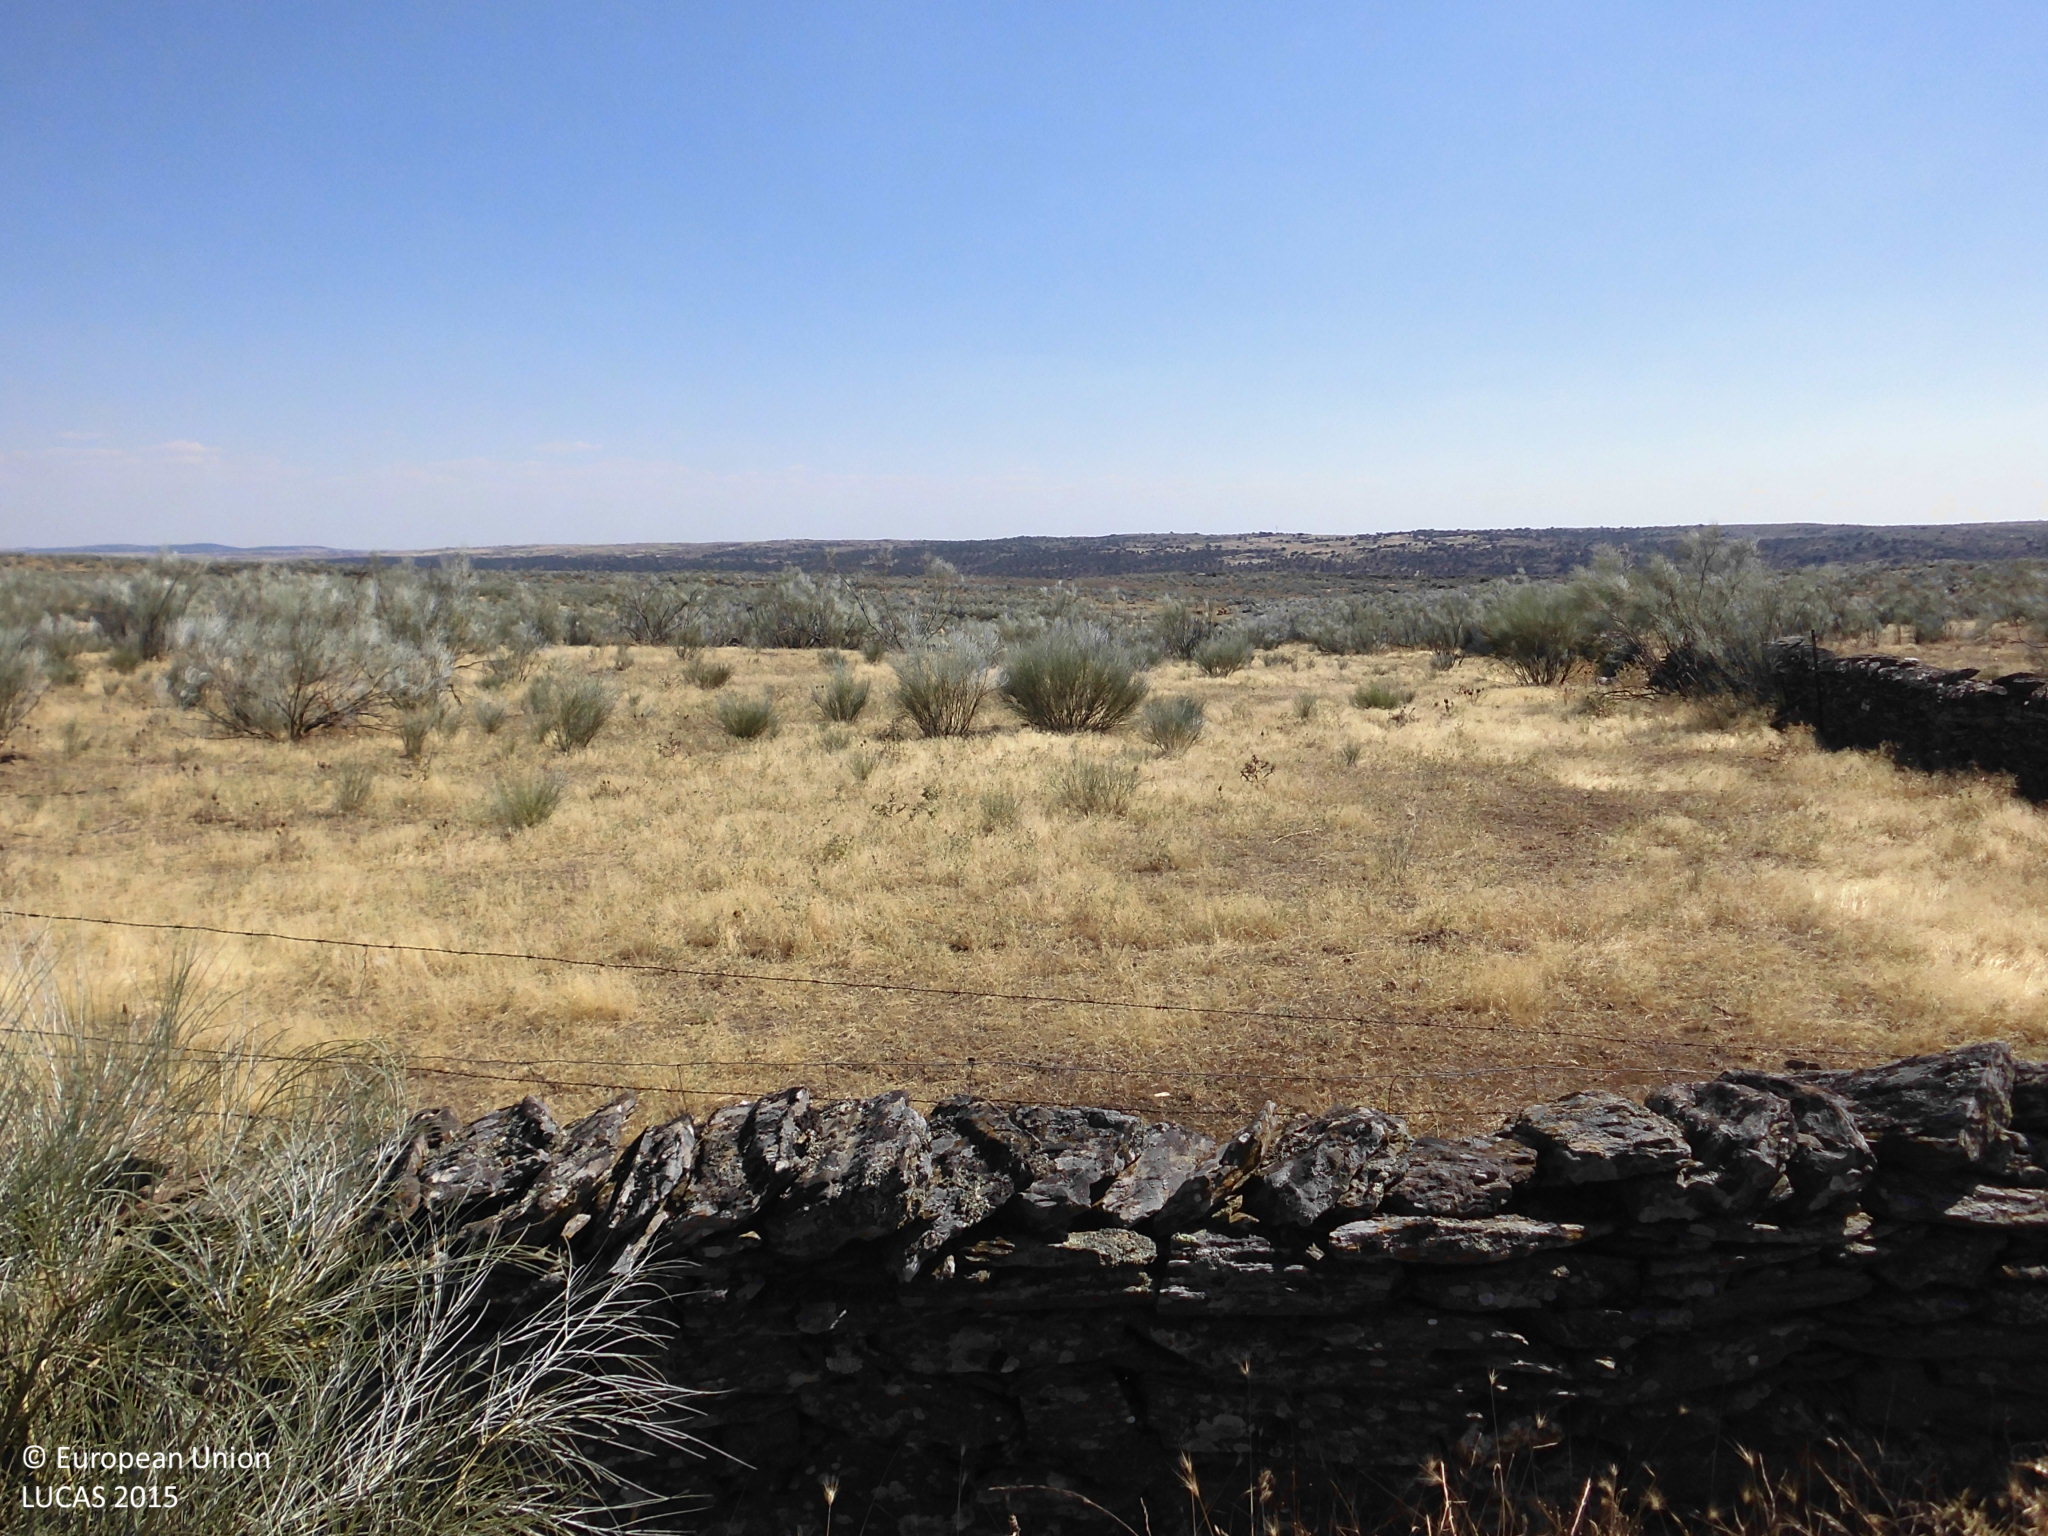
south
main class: Shrubland
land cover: Shrubland without tree cover
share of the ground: 10 - 25 %
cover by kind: herbaceous plants 80 %, shrubs 20 %
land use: Agriculture (excluding fallow land and kitchen gardens)
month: June
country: ES
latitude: 39.6642
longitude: -6.4262
